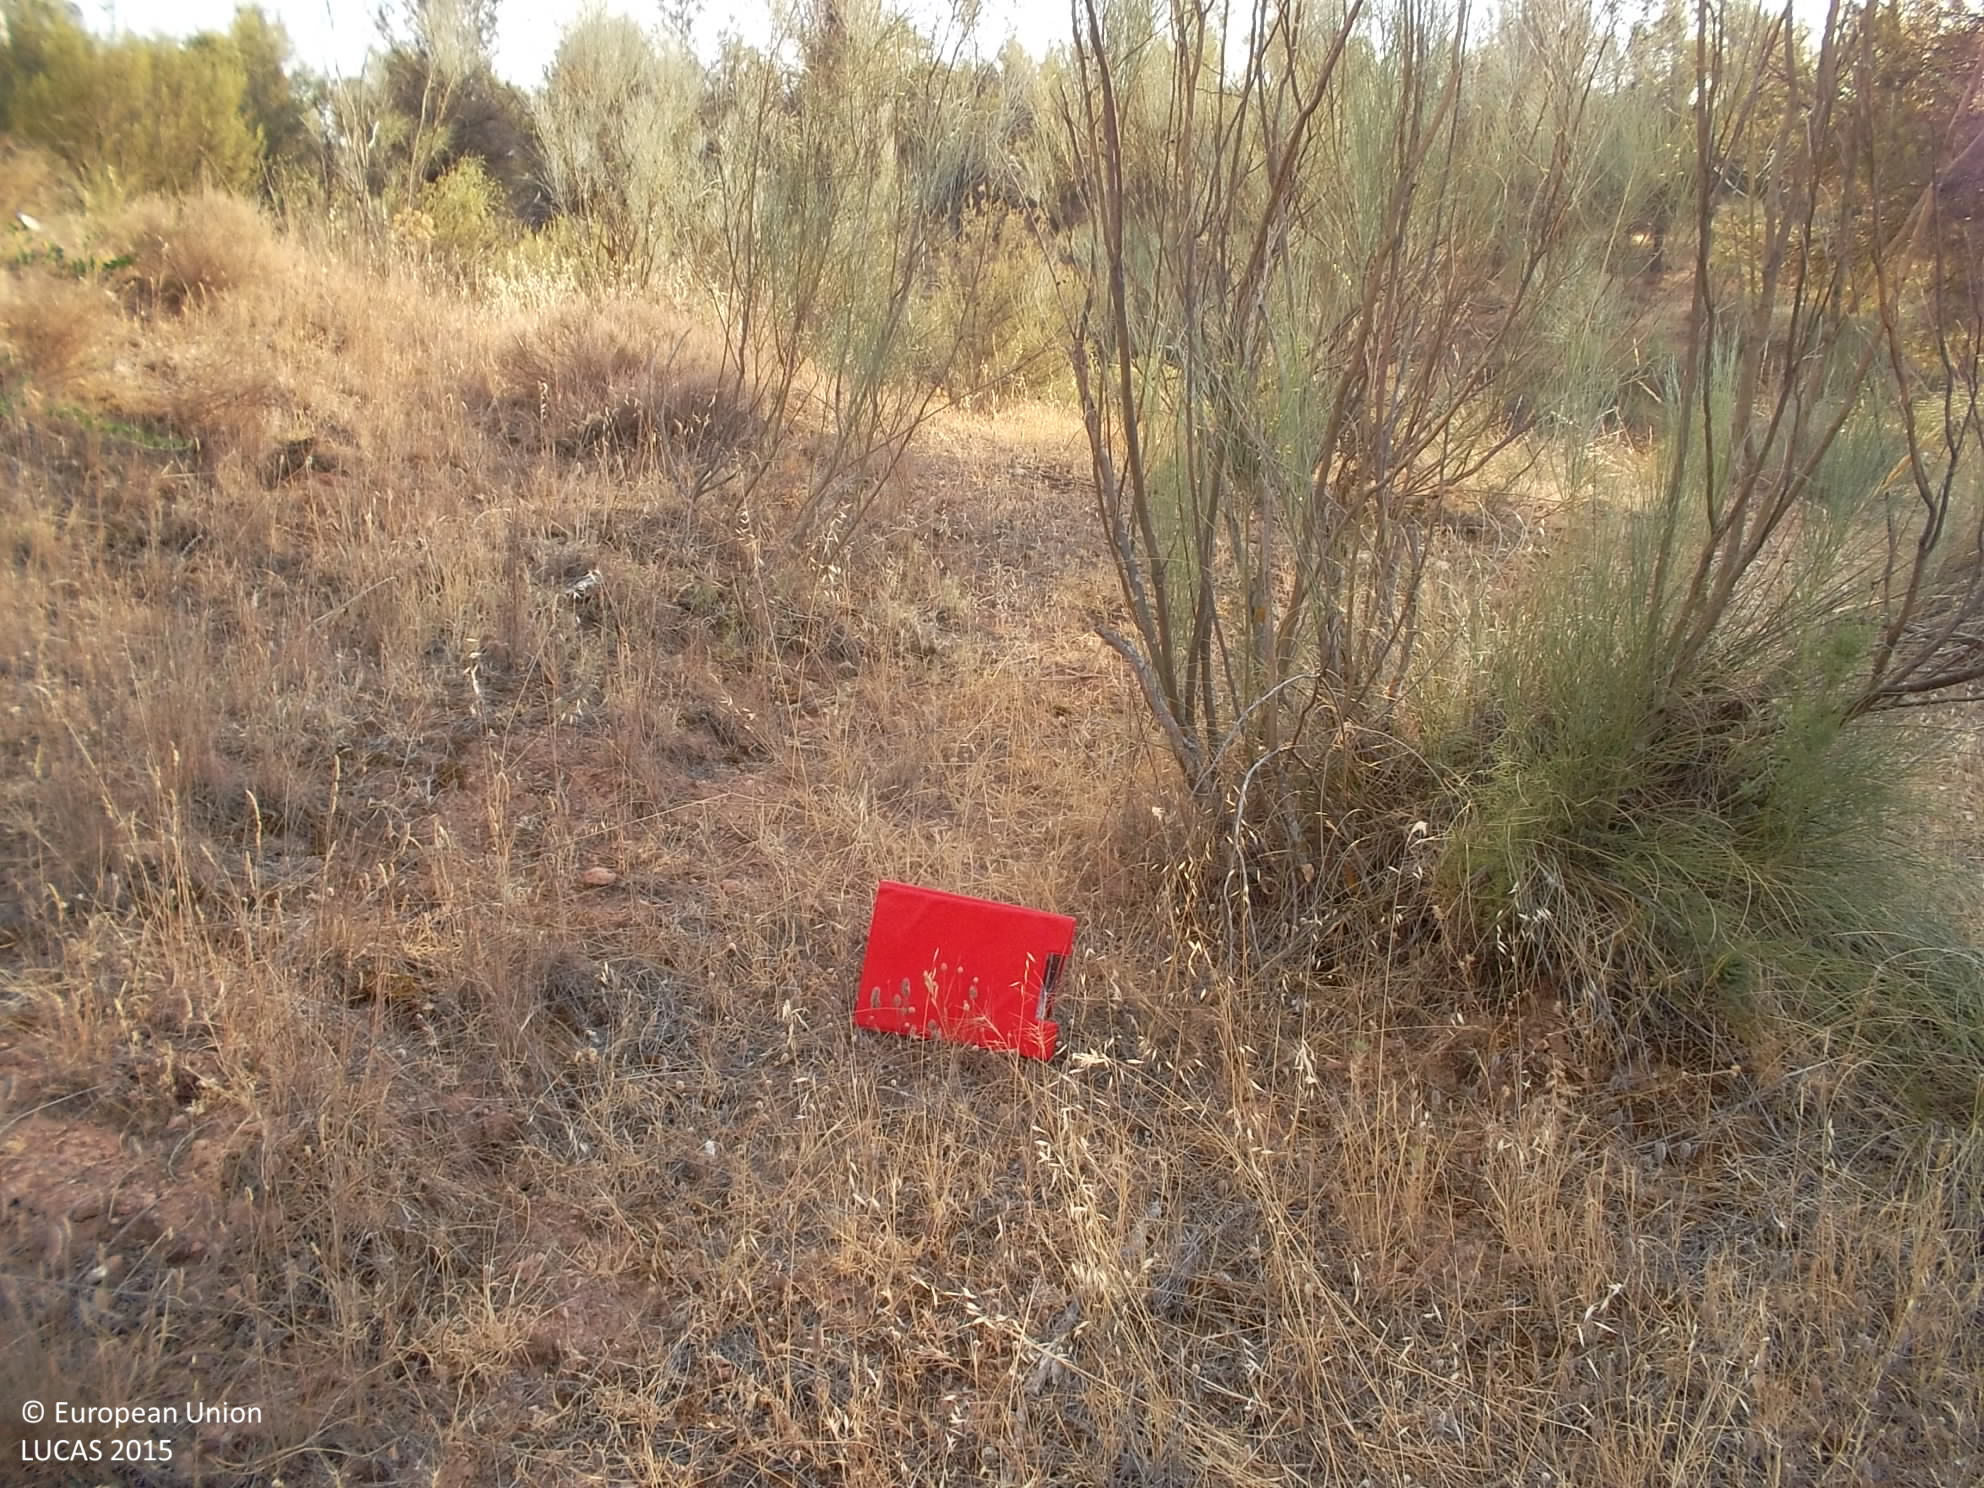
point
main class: Woodland
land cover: Pine dominated coniferous woodland
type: coniferous forest of the mediterranean region
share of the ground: 25 - 50 %
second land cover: Shrubland without tree cover
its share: 25 - 50 %
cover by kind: shrubs 40 %, coniferous forest trees 30 %, herbaceous plants 30 %
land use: Forestry
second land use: Agriculture (excluding fallow land and kitchen gardens)
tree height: > 5 m
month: June
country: ES
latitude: 37.8097
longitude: -3.2285
